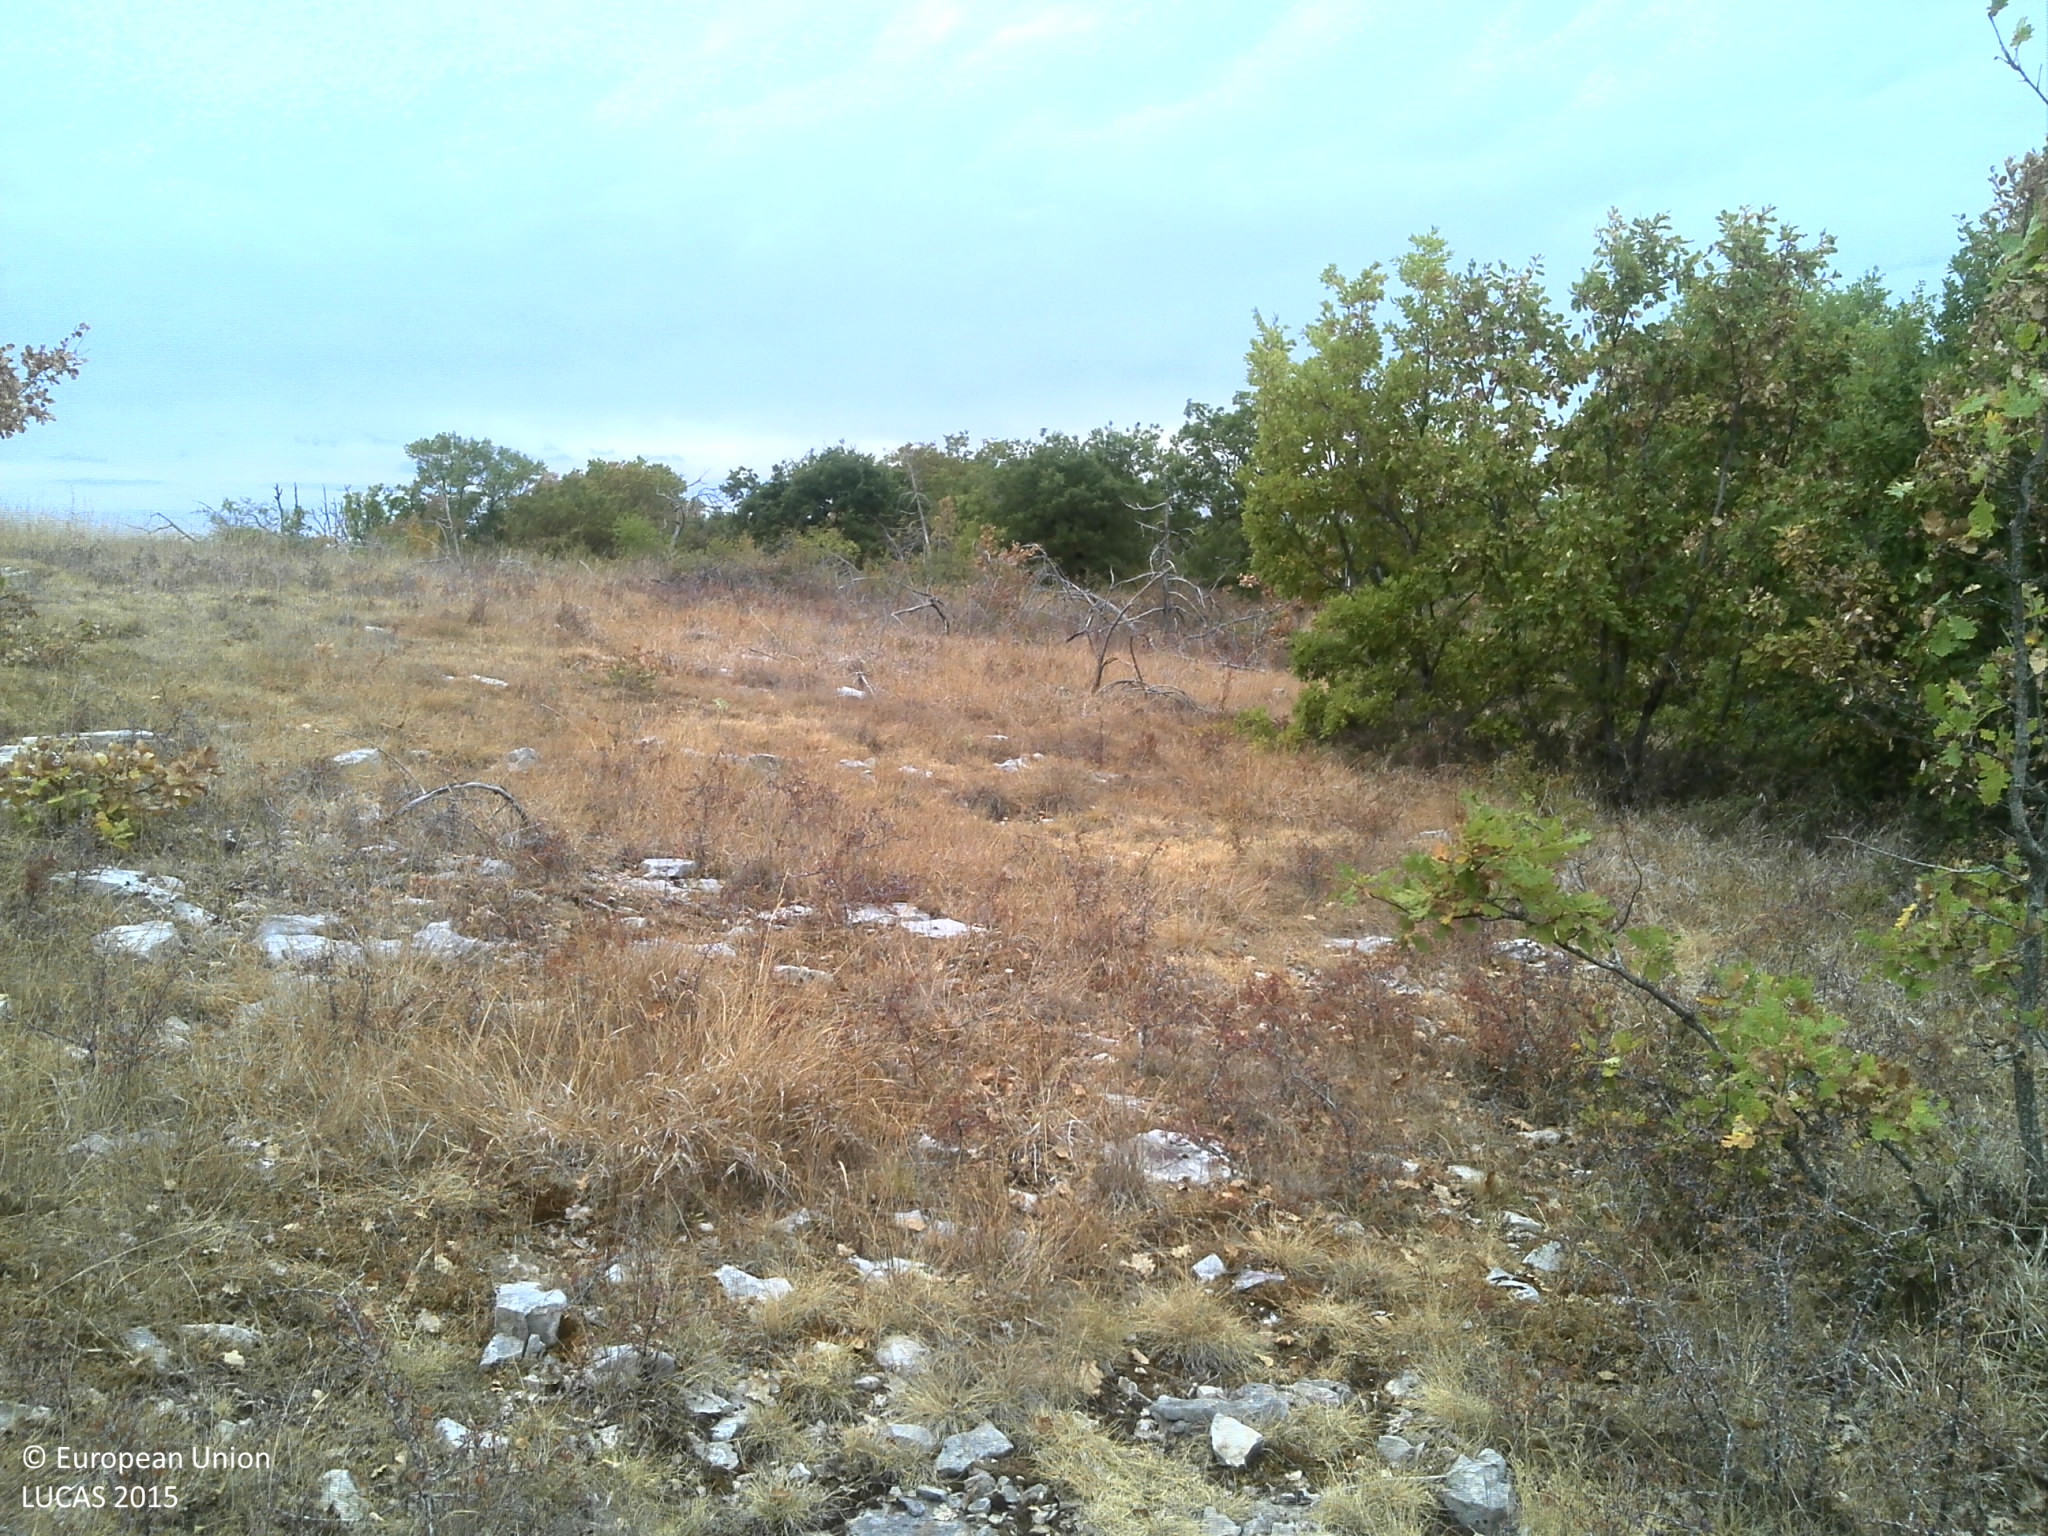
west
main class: Shrubland
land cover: Shrubland with sparse tree cover
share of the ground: > 75 %
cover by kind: shrubs 50 %, herbaceous plants 40 %, broadleaved forest trees 5 %, lichens and mosses 5 %
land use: Semi-natural and natural areas not in use
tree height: < 5 m
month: July
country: FR
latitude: 45.0821
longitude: 1.4198
